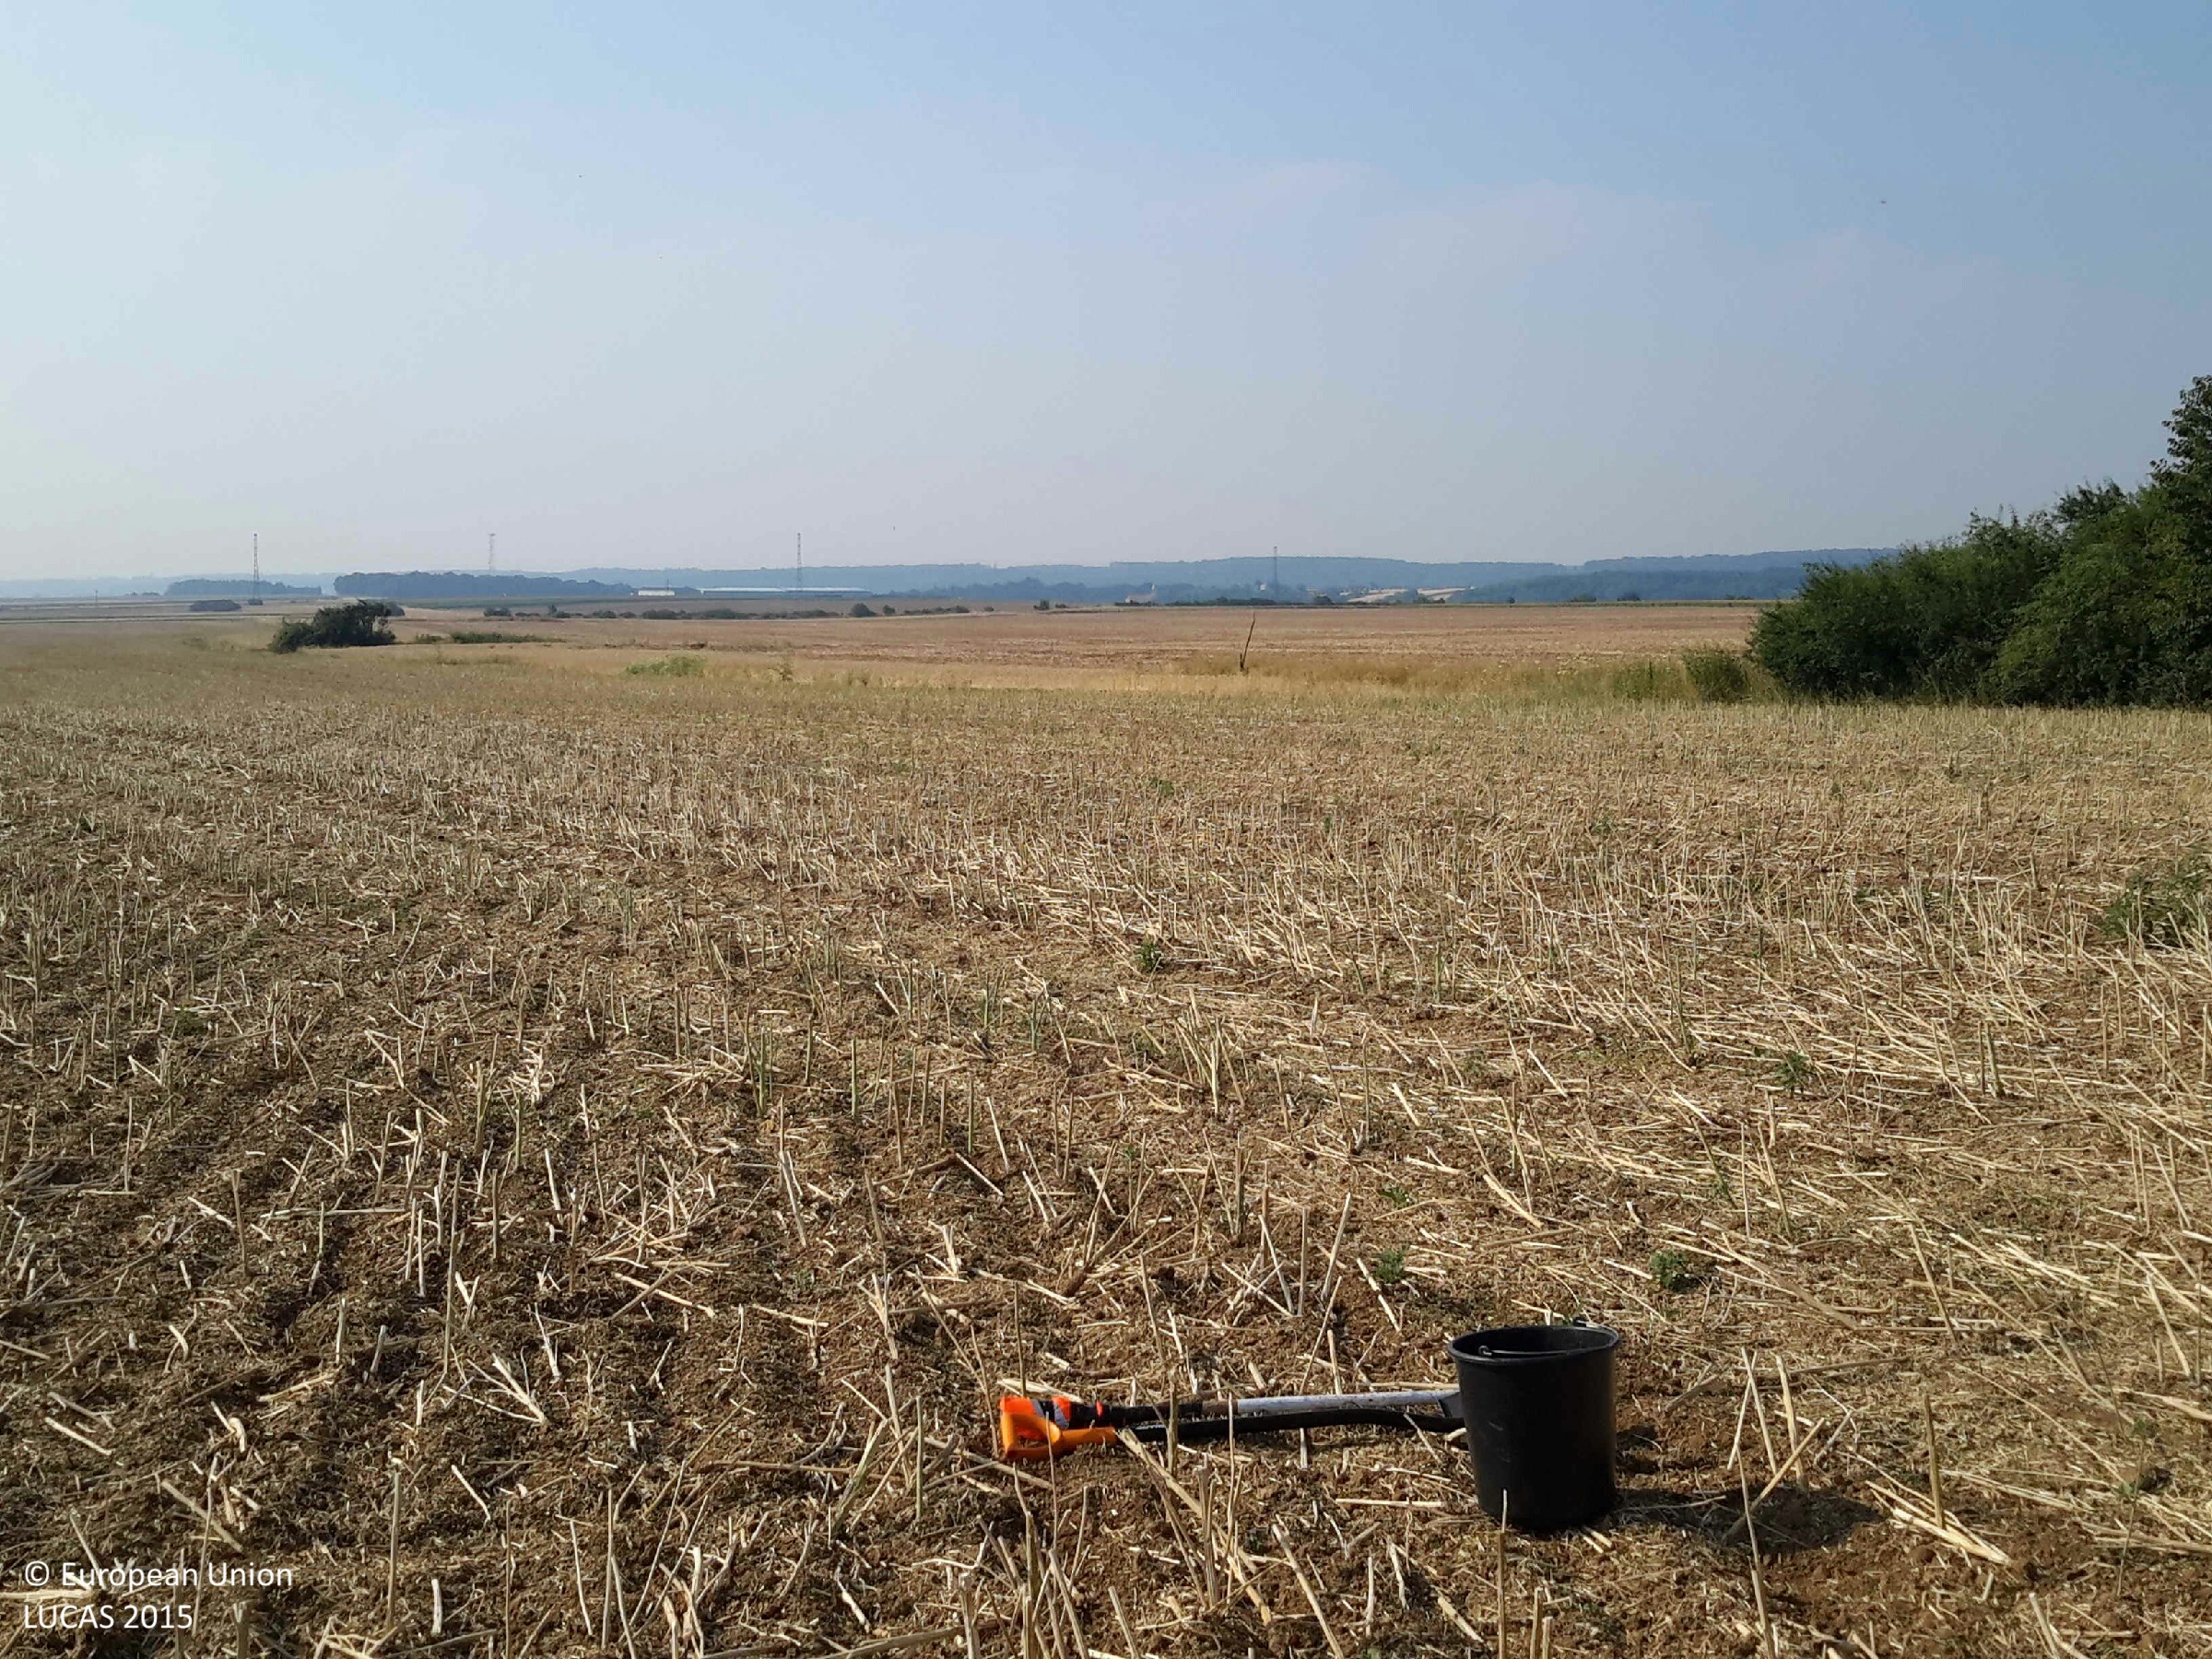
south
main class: Cropland
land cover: Rape and turnip rape
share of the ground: 10 - 25 %
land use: Agriculture (excluding fallow land and kitchen gardens)
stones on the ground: < 10 %
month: July
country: HU
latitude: 47.4450
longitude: 16.6482
